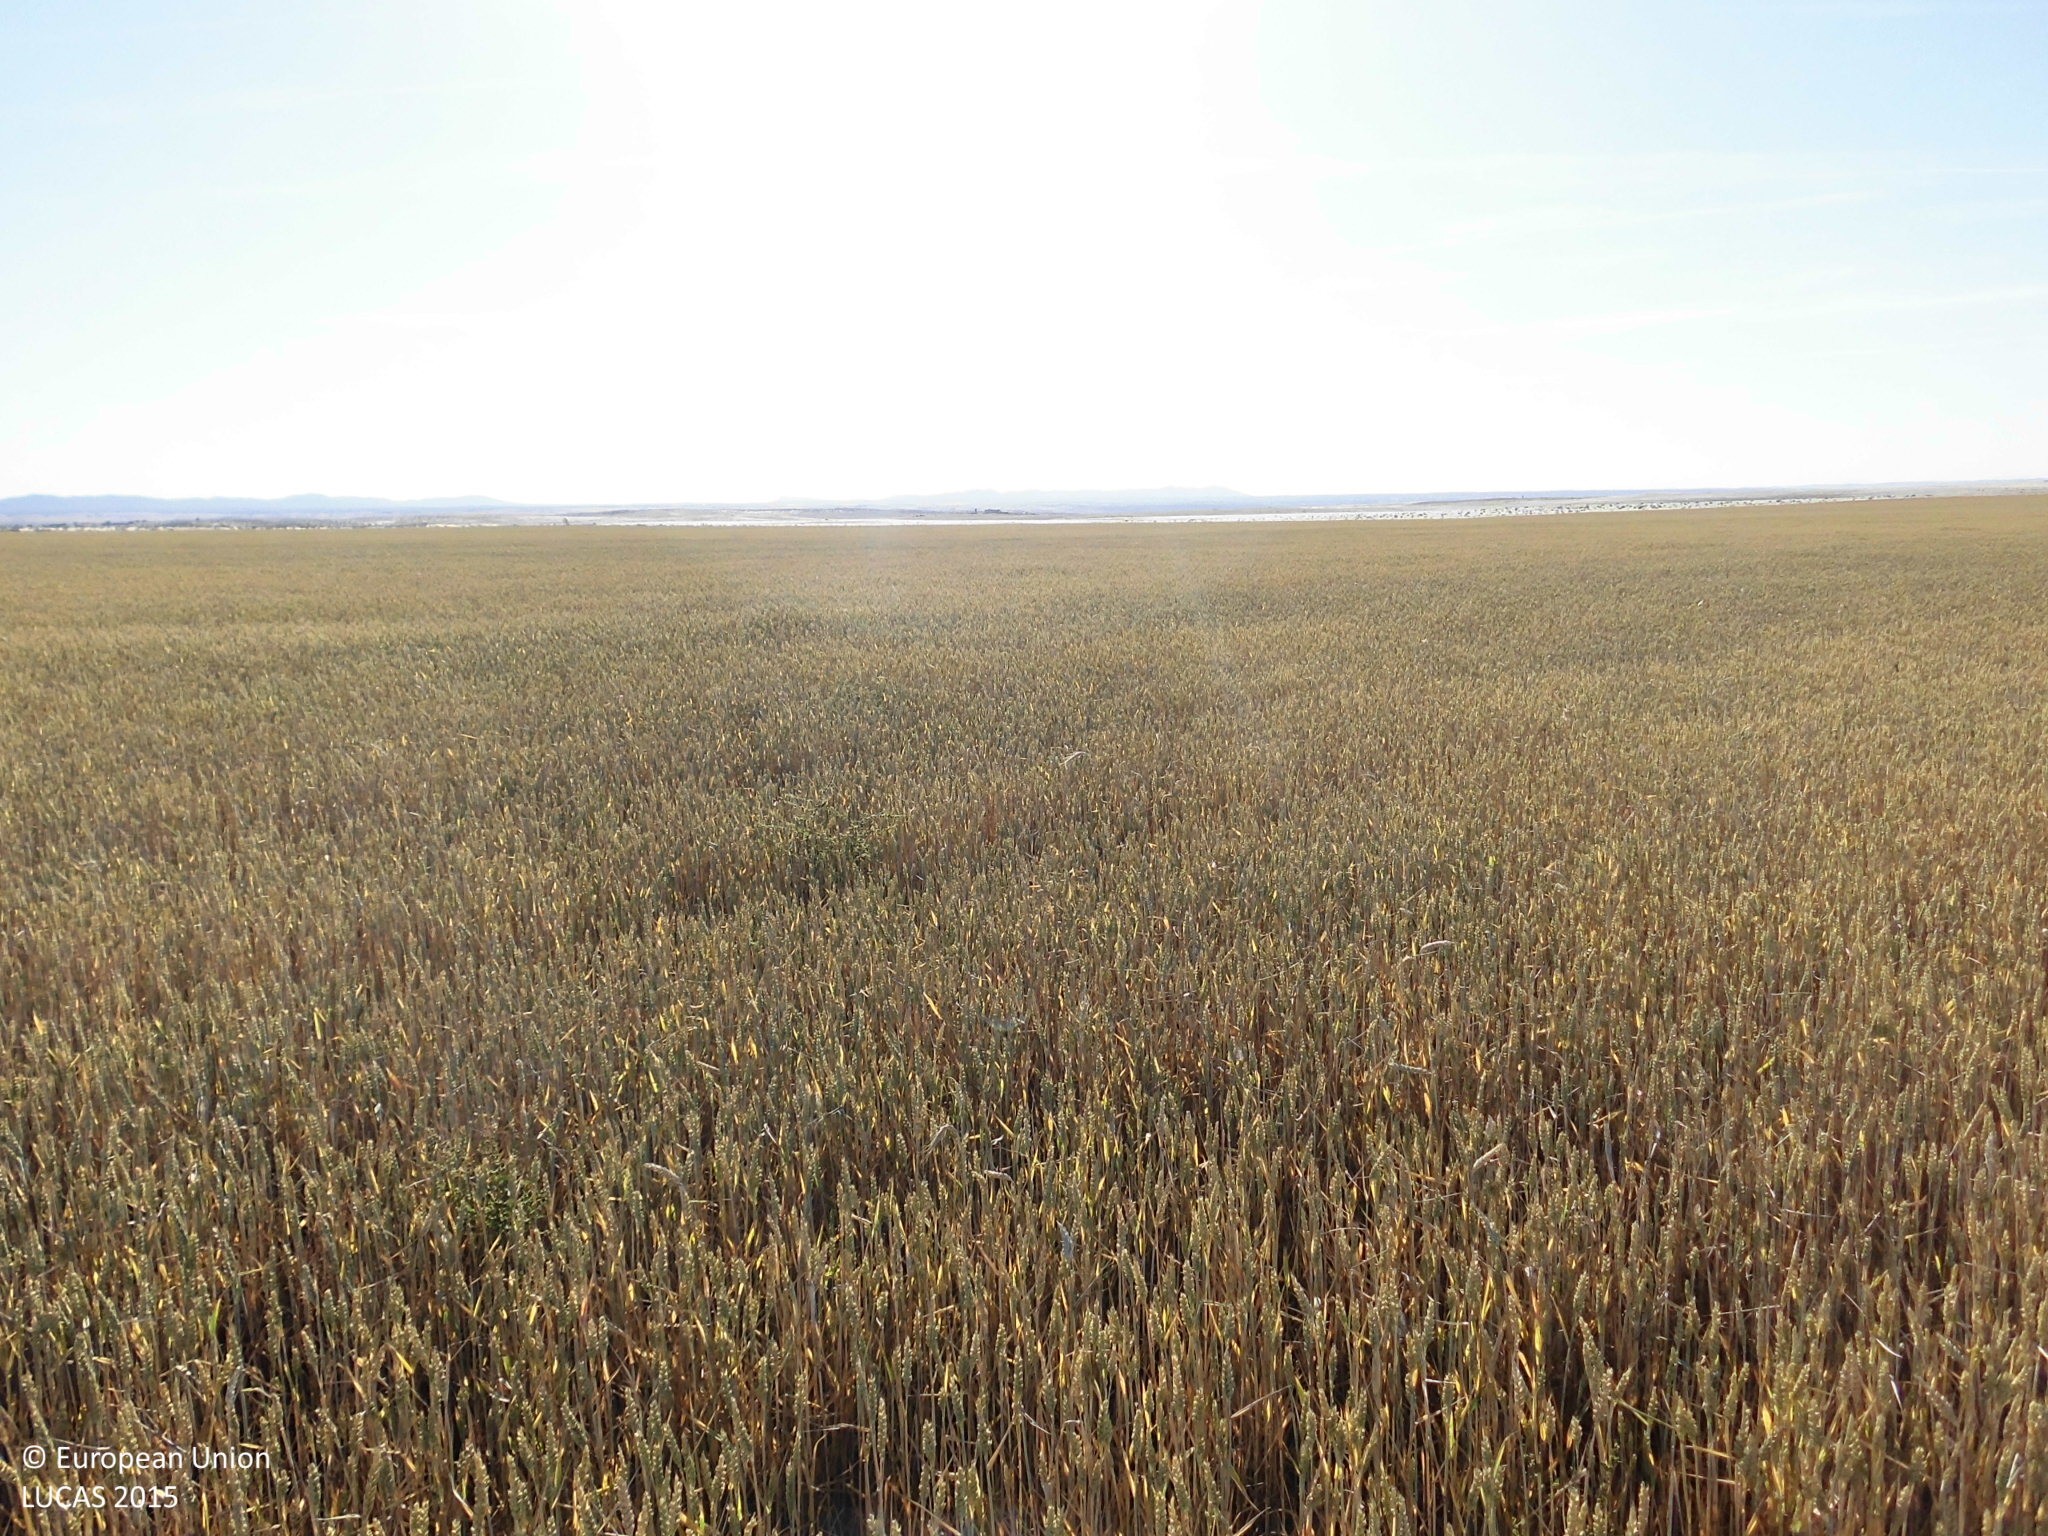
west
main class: Cropland
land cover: Common wheat
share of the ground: > 75 %
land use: Agriculture (excluding fallow land and kitchen gardens)
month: May
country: ES
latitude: 39.5148
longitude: -6.8631
